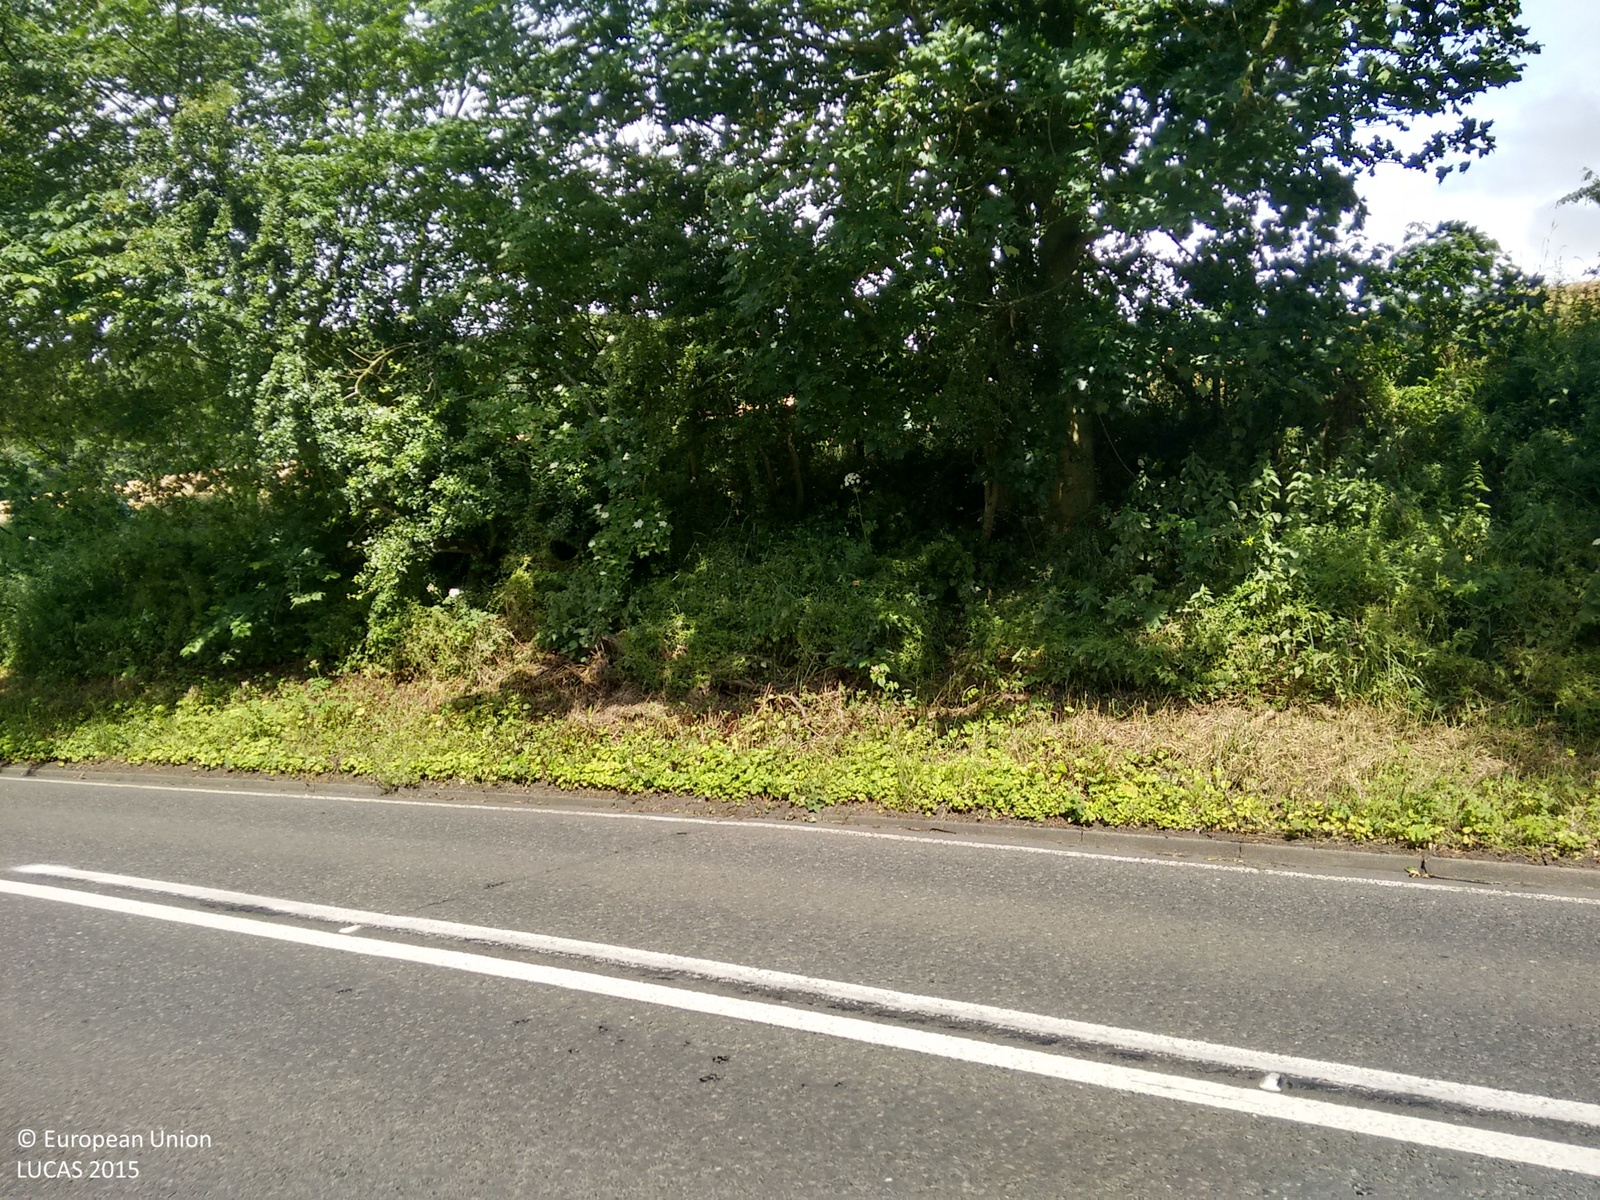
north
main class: Woodland
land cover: Broadleaved woodland
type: mesophytic deciduous forest
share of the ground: > 75 %
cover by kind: broadleaved forest trees 100 %
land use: Forestry
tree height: > 5 m
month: July
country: GB
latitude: 56.0582
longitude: -3.2894
